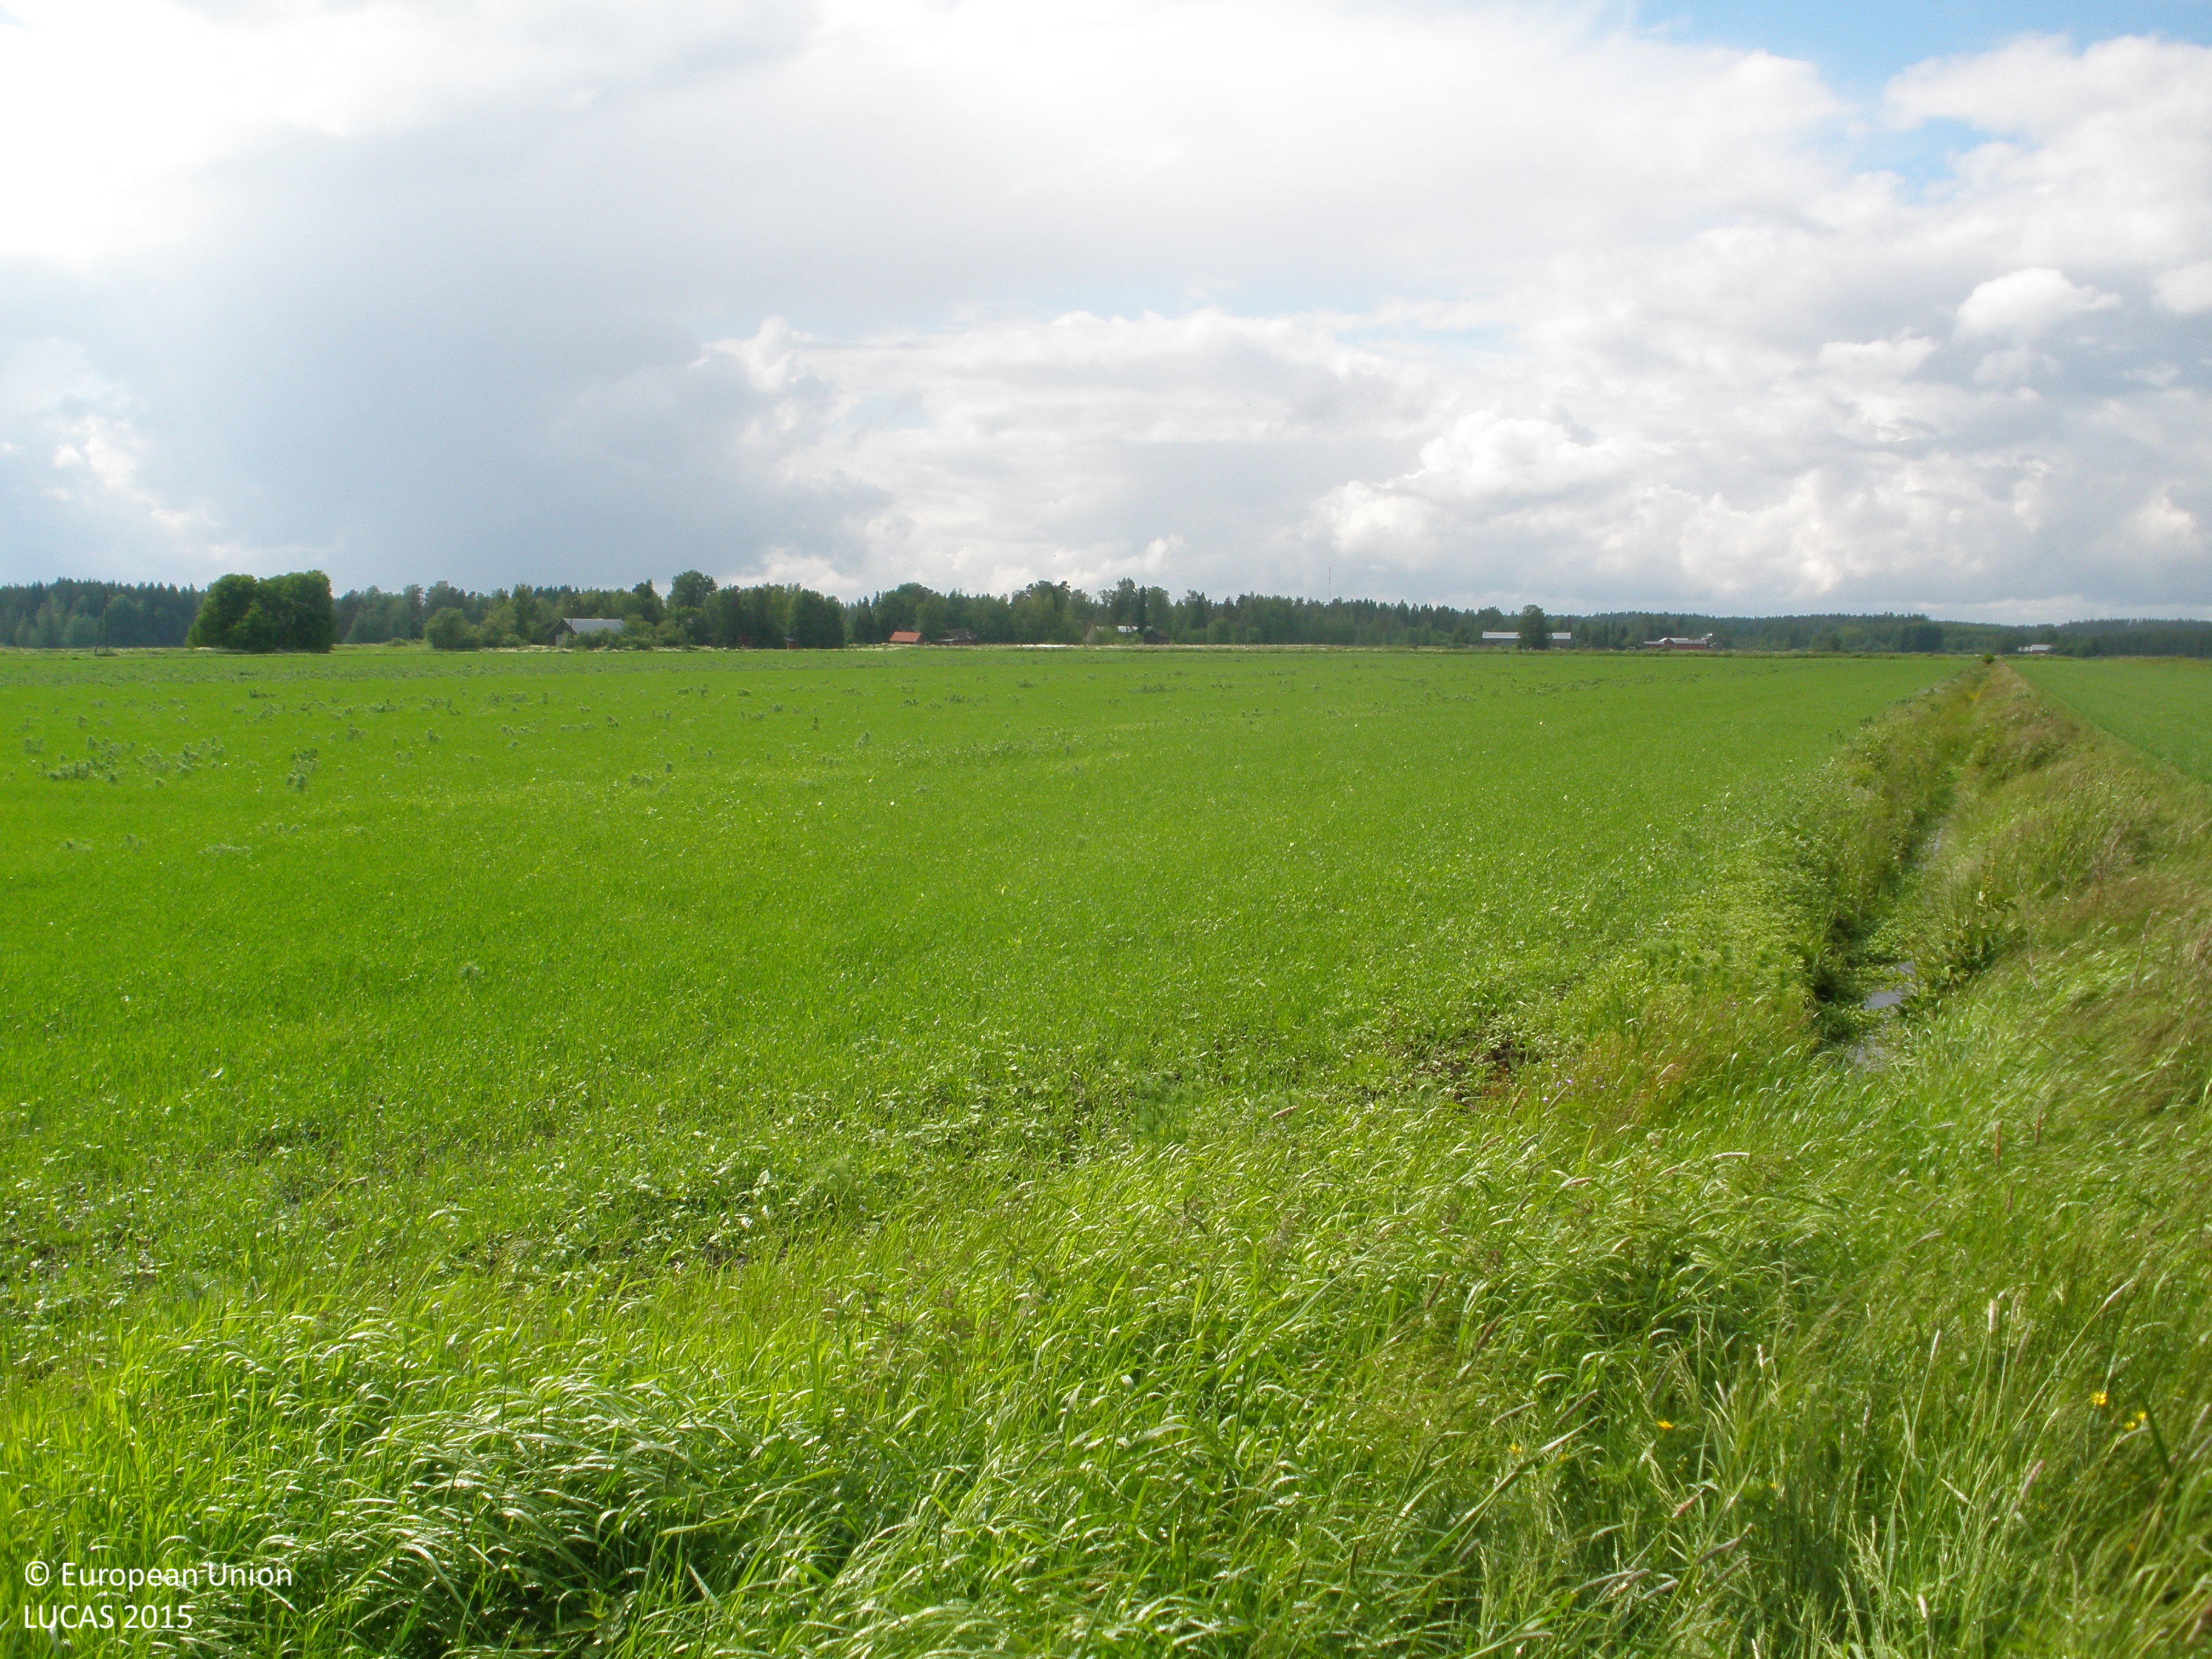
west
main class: Cropland
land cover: Barley
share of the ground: > 75 %
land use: Agriculture (excluding fallow land and kitchen gardens)
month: June
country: FI
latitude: 60.9517
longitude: 23.5437
